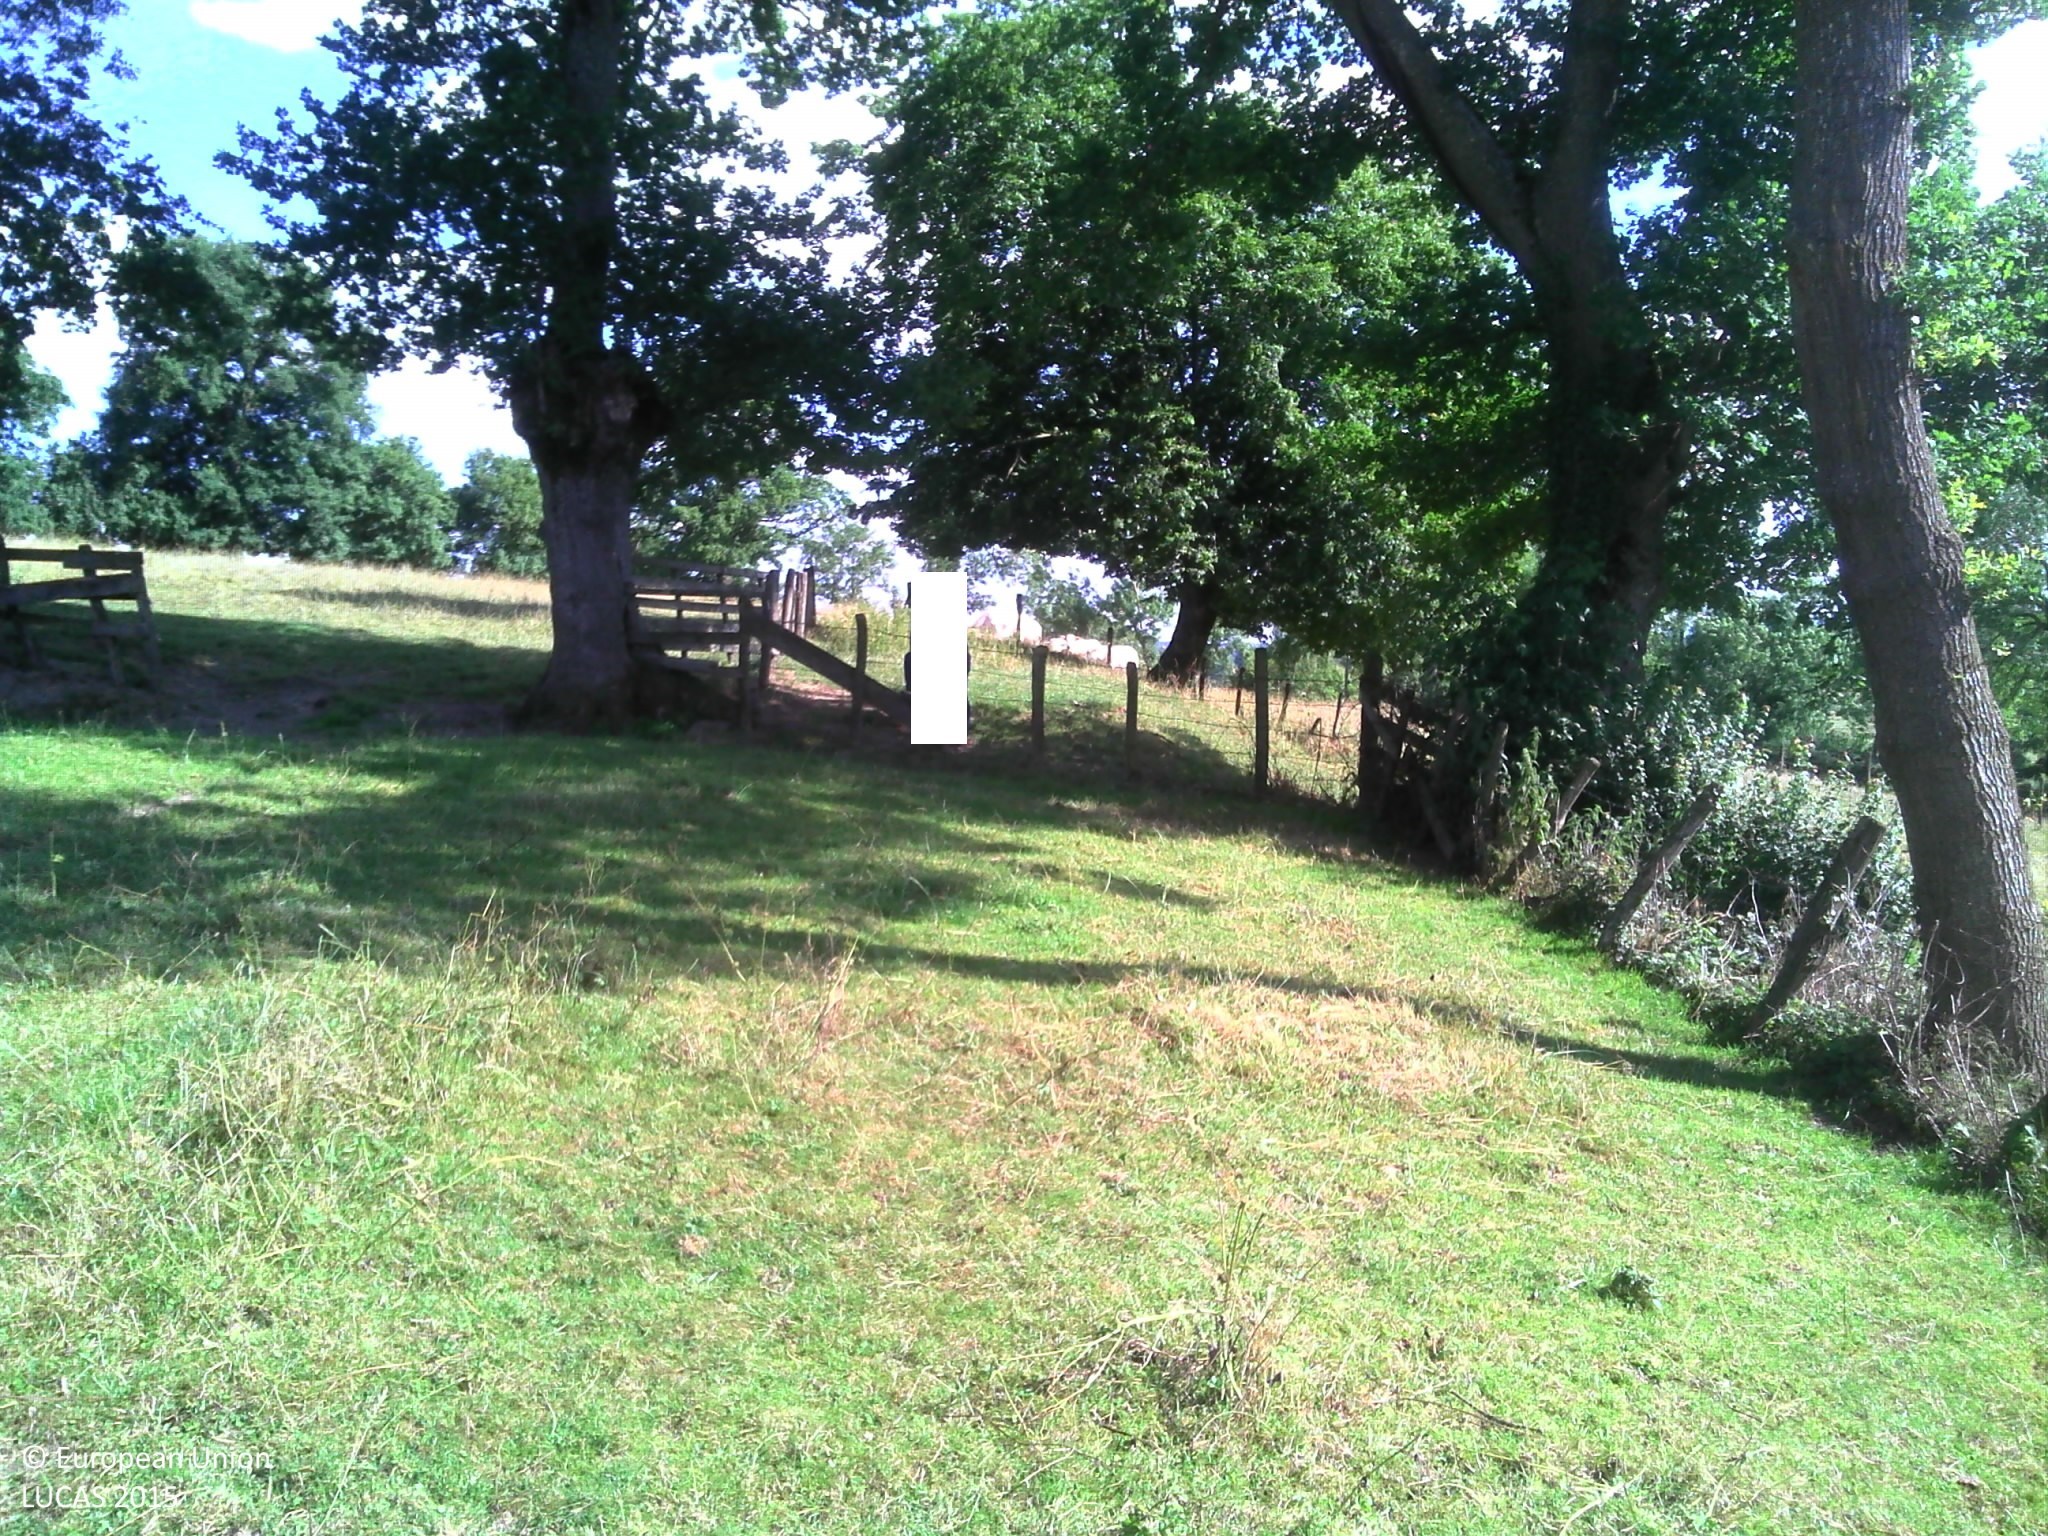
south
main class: Grassland
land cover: Grassland without tree/shrub cover
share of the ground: > 75 %
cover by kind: herbaceous plants 100 %
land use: Agriculture (excluding fallow land and kitchen gardens)
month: June
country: FR
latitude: 46.3667
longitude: 4.0604
